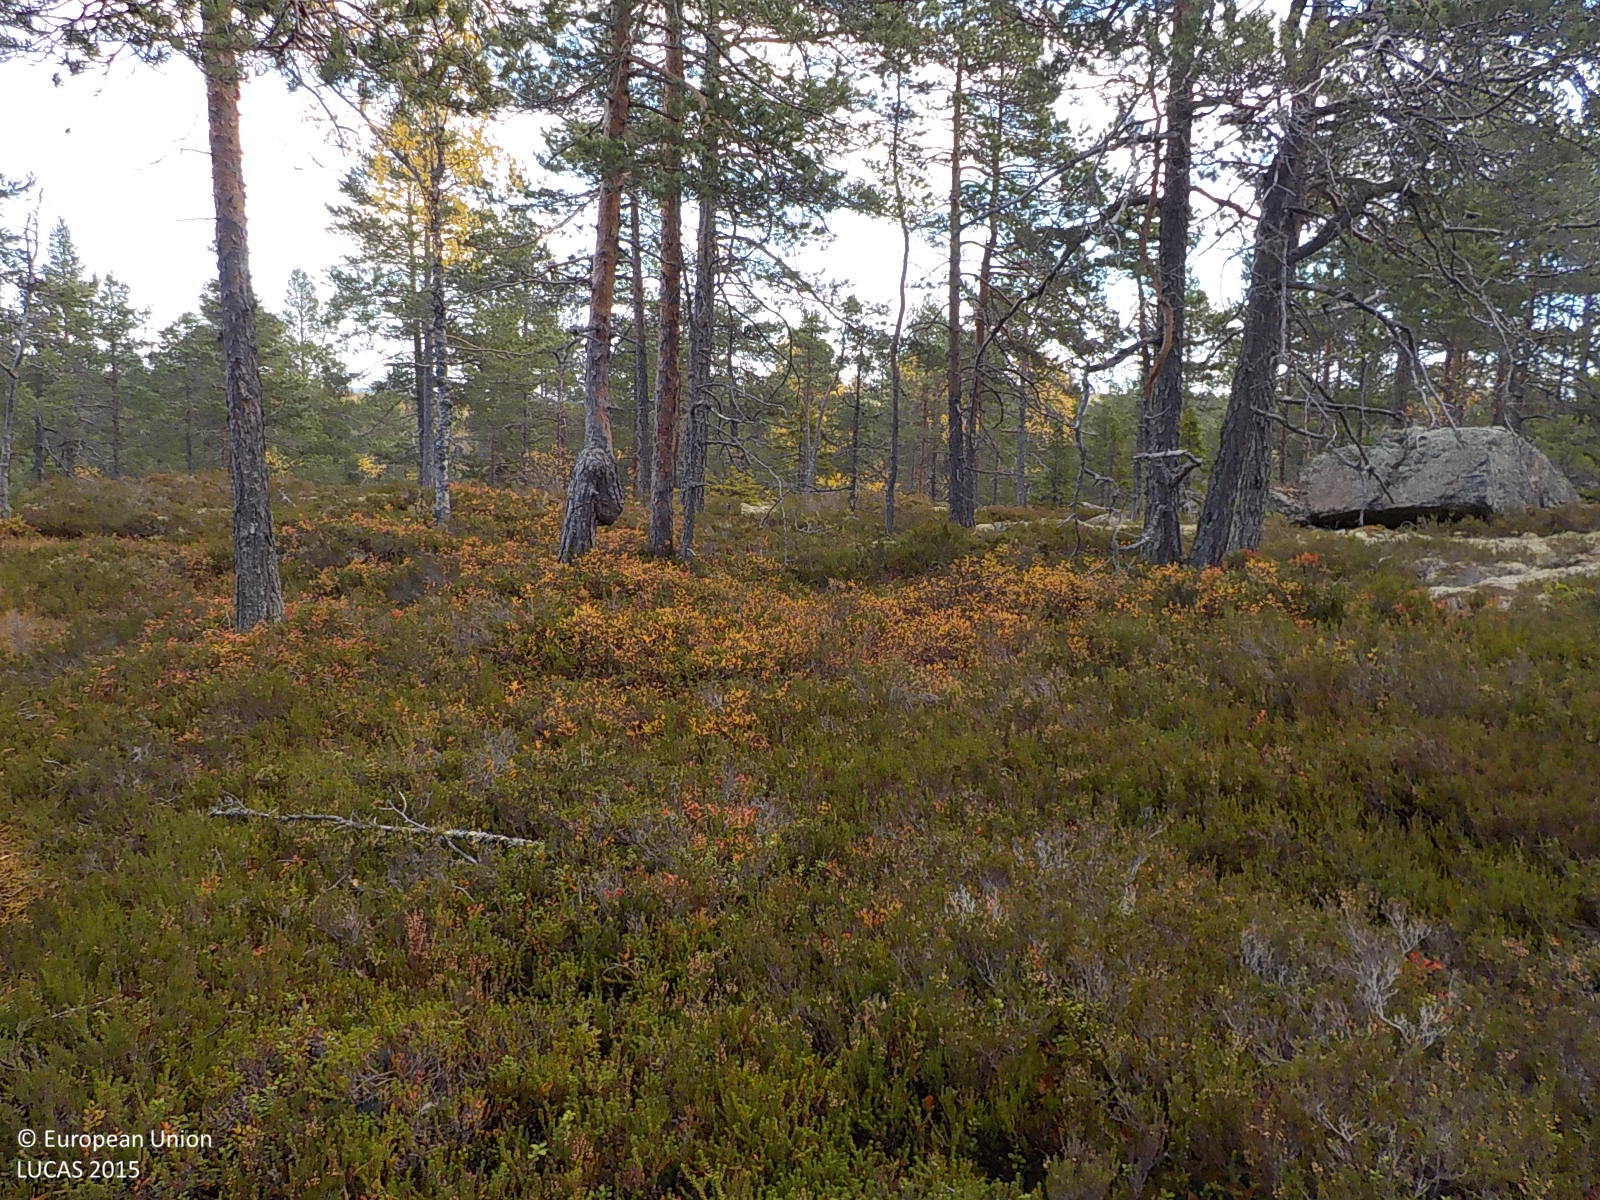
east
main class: Woodland
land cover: Pine dominated coniferous woodland
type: boreal forest
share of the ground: 10 - 25 %
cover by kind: shrubs 50 %, coniferous forest trees 20 %, lichens and mosses 15 %, consolidated bare surface 15 %
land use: Semi-natural and natural areas not in use
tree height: > 5 m
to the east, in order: Pine dominated coniferous woodland; Rivers and streams; Spruce dominated coniferous woodland; Spruce dominated mixed woodland
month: October
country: SE
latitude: 62.9921
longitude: 18.4472
